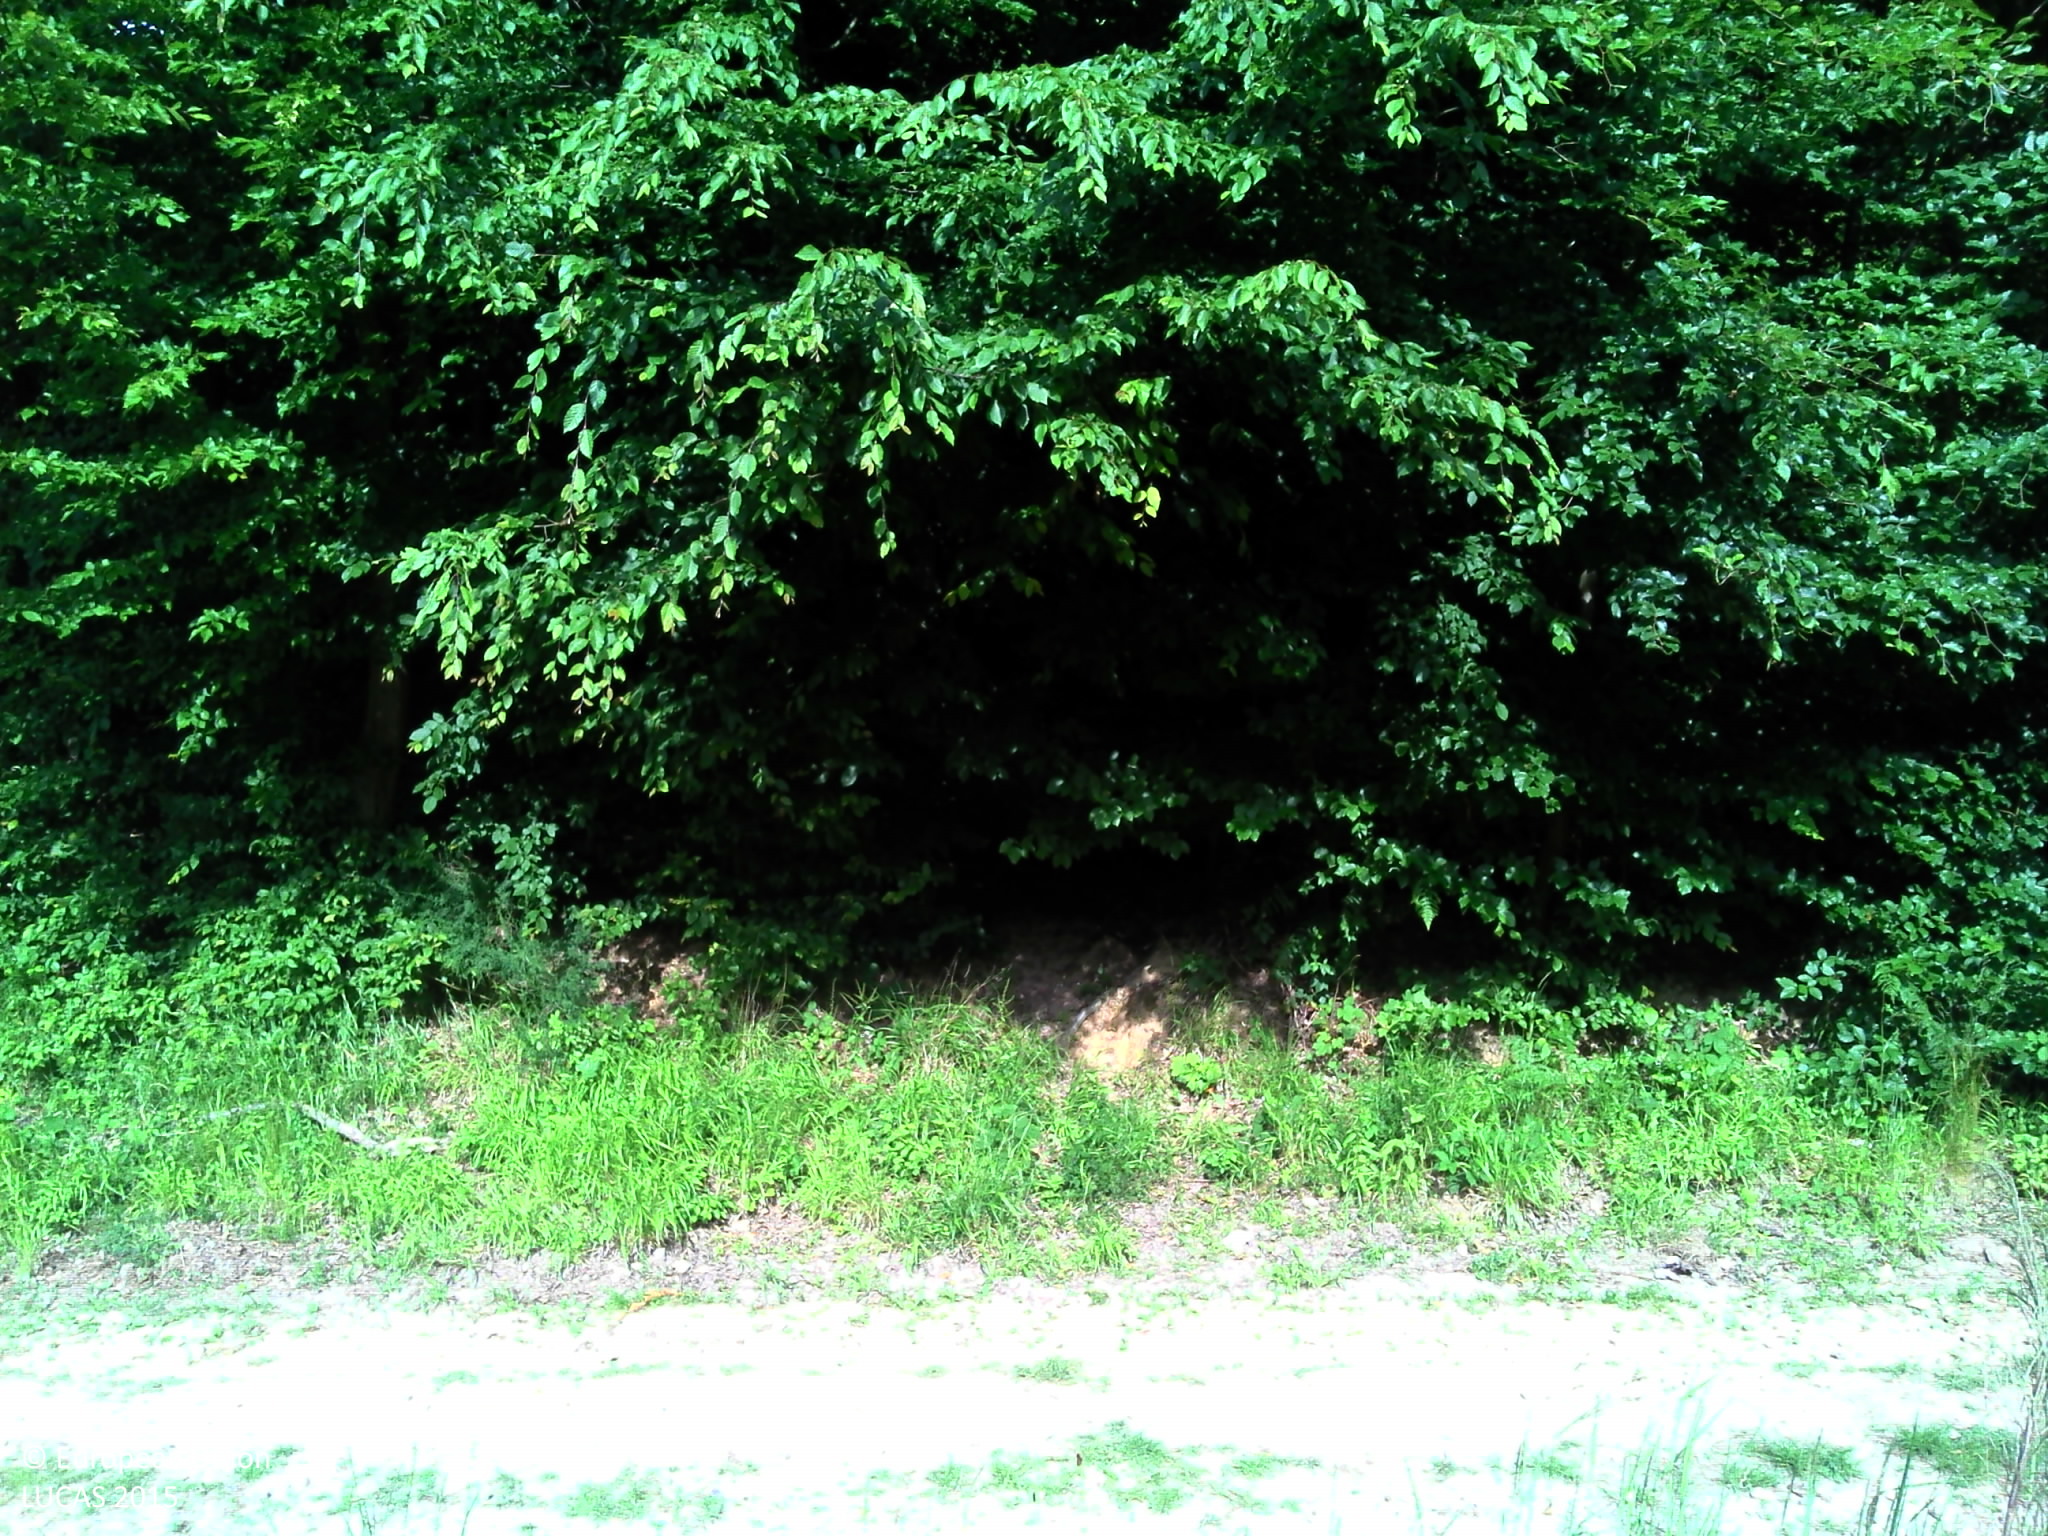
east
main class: Grassland
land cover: Spontaneously vegetated surfaces
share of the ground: > 75 %
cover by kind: herbaceous plants 100 %
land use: Semi-natural and natural areas not in use
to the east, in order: Spontaneously vegetated surfaces; Tracks; Grass margins; Broadleaved woodland
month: June
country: FR
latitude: 49.2779
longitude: 1.1406
